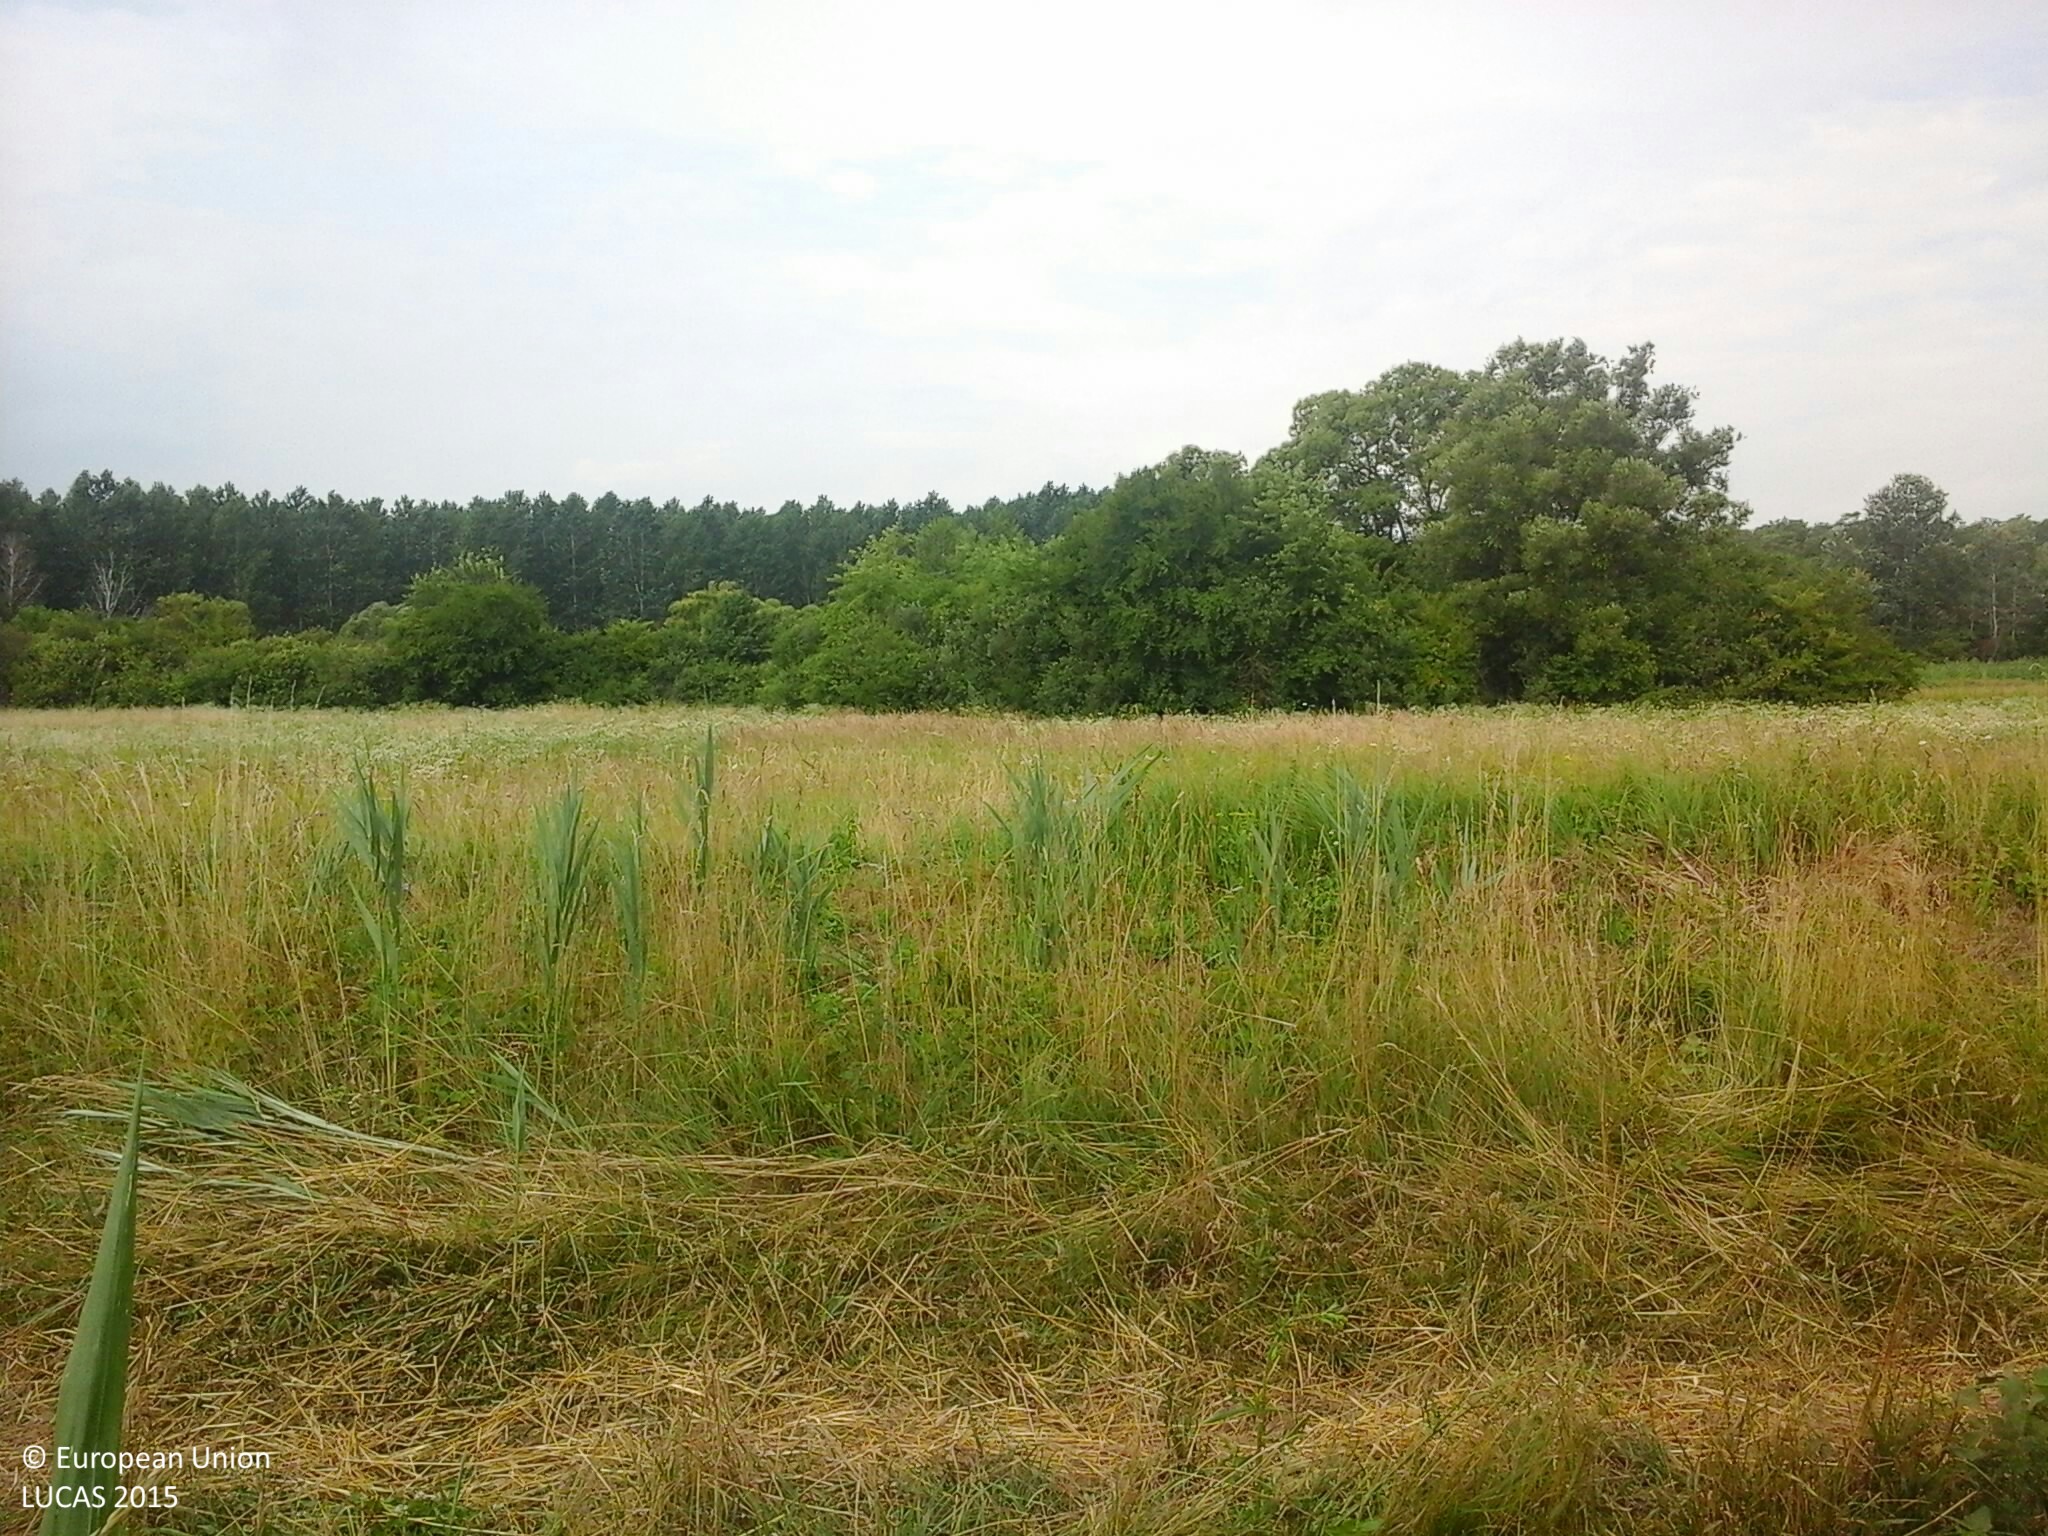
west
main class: Cropland
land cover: Maize
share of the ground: > 75 %
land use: Agriculture (excluding fallow land and kitchen gardens)
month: July
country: HU
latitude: 47.6867
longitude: 22.2170
